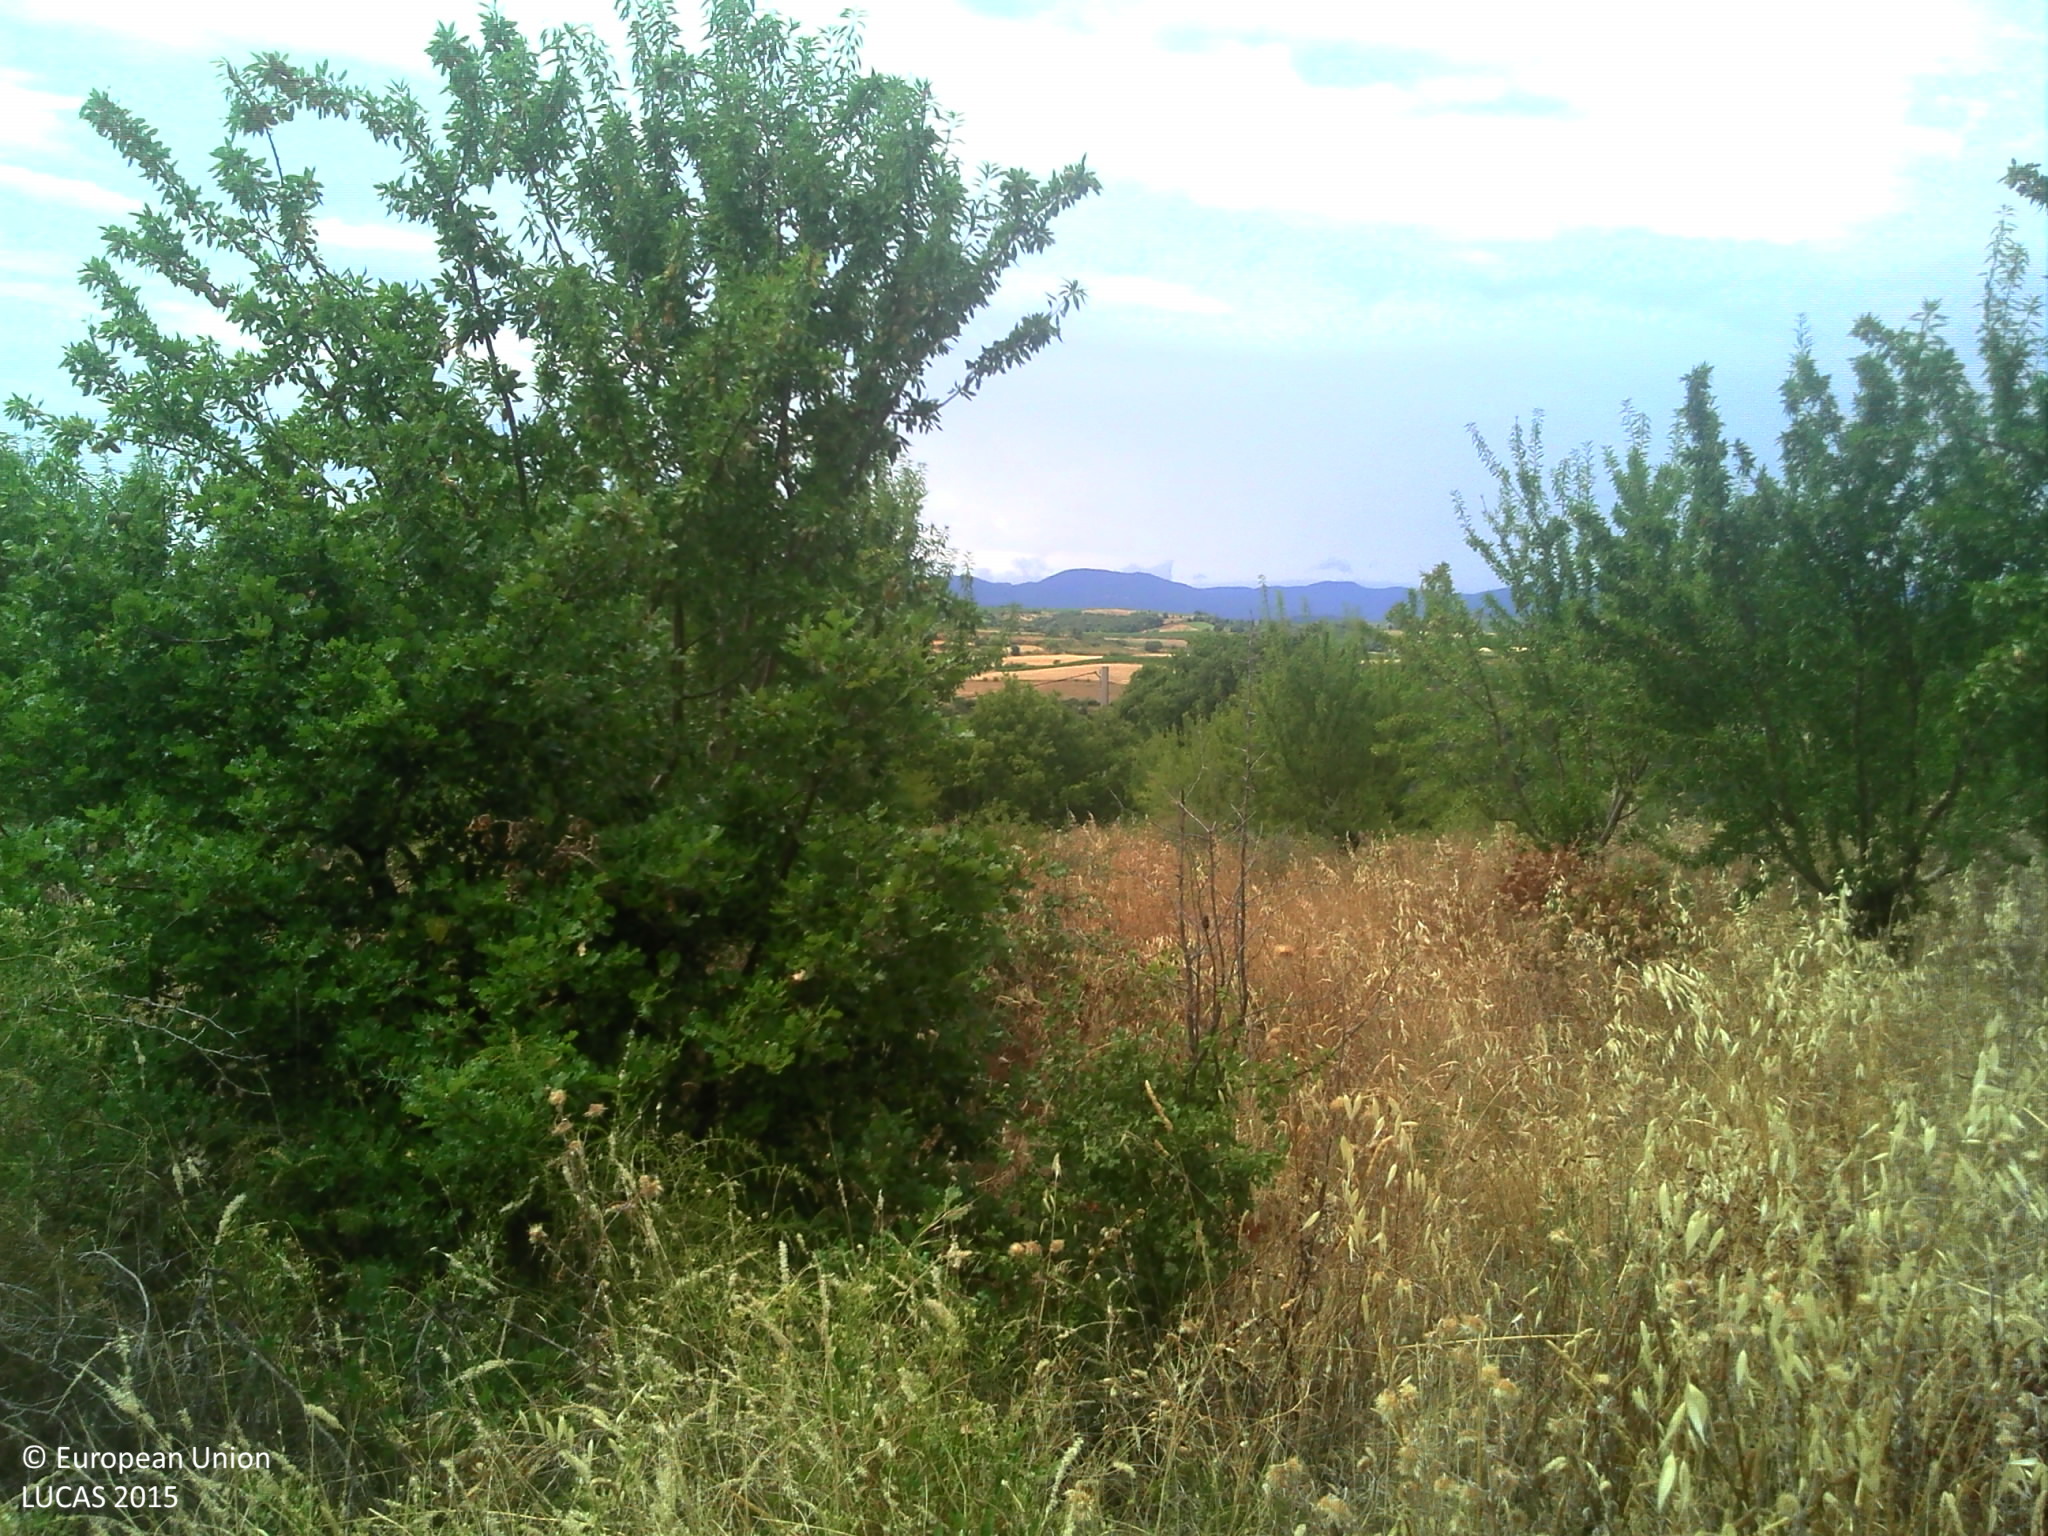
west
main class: Cropland
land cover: Nuts trees
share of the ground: 25 - 50 %
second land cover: Spontaneously vegetated surfaces
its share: > 75 %
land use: Agriculture (excluding fallow land and kitchen gardens)
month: July
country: FR
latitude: 43.4527
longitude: 3.1254
